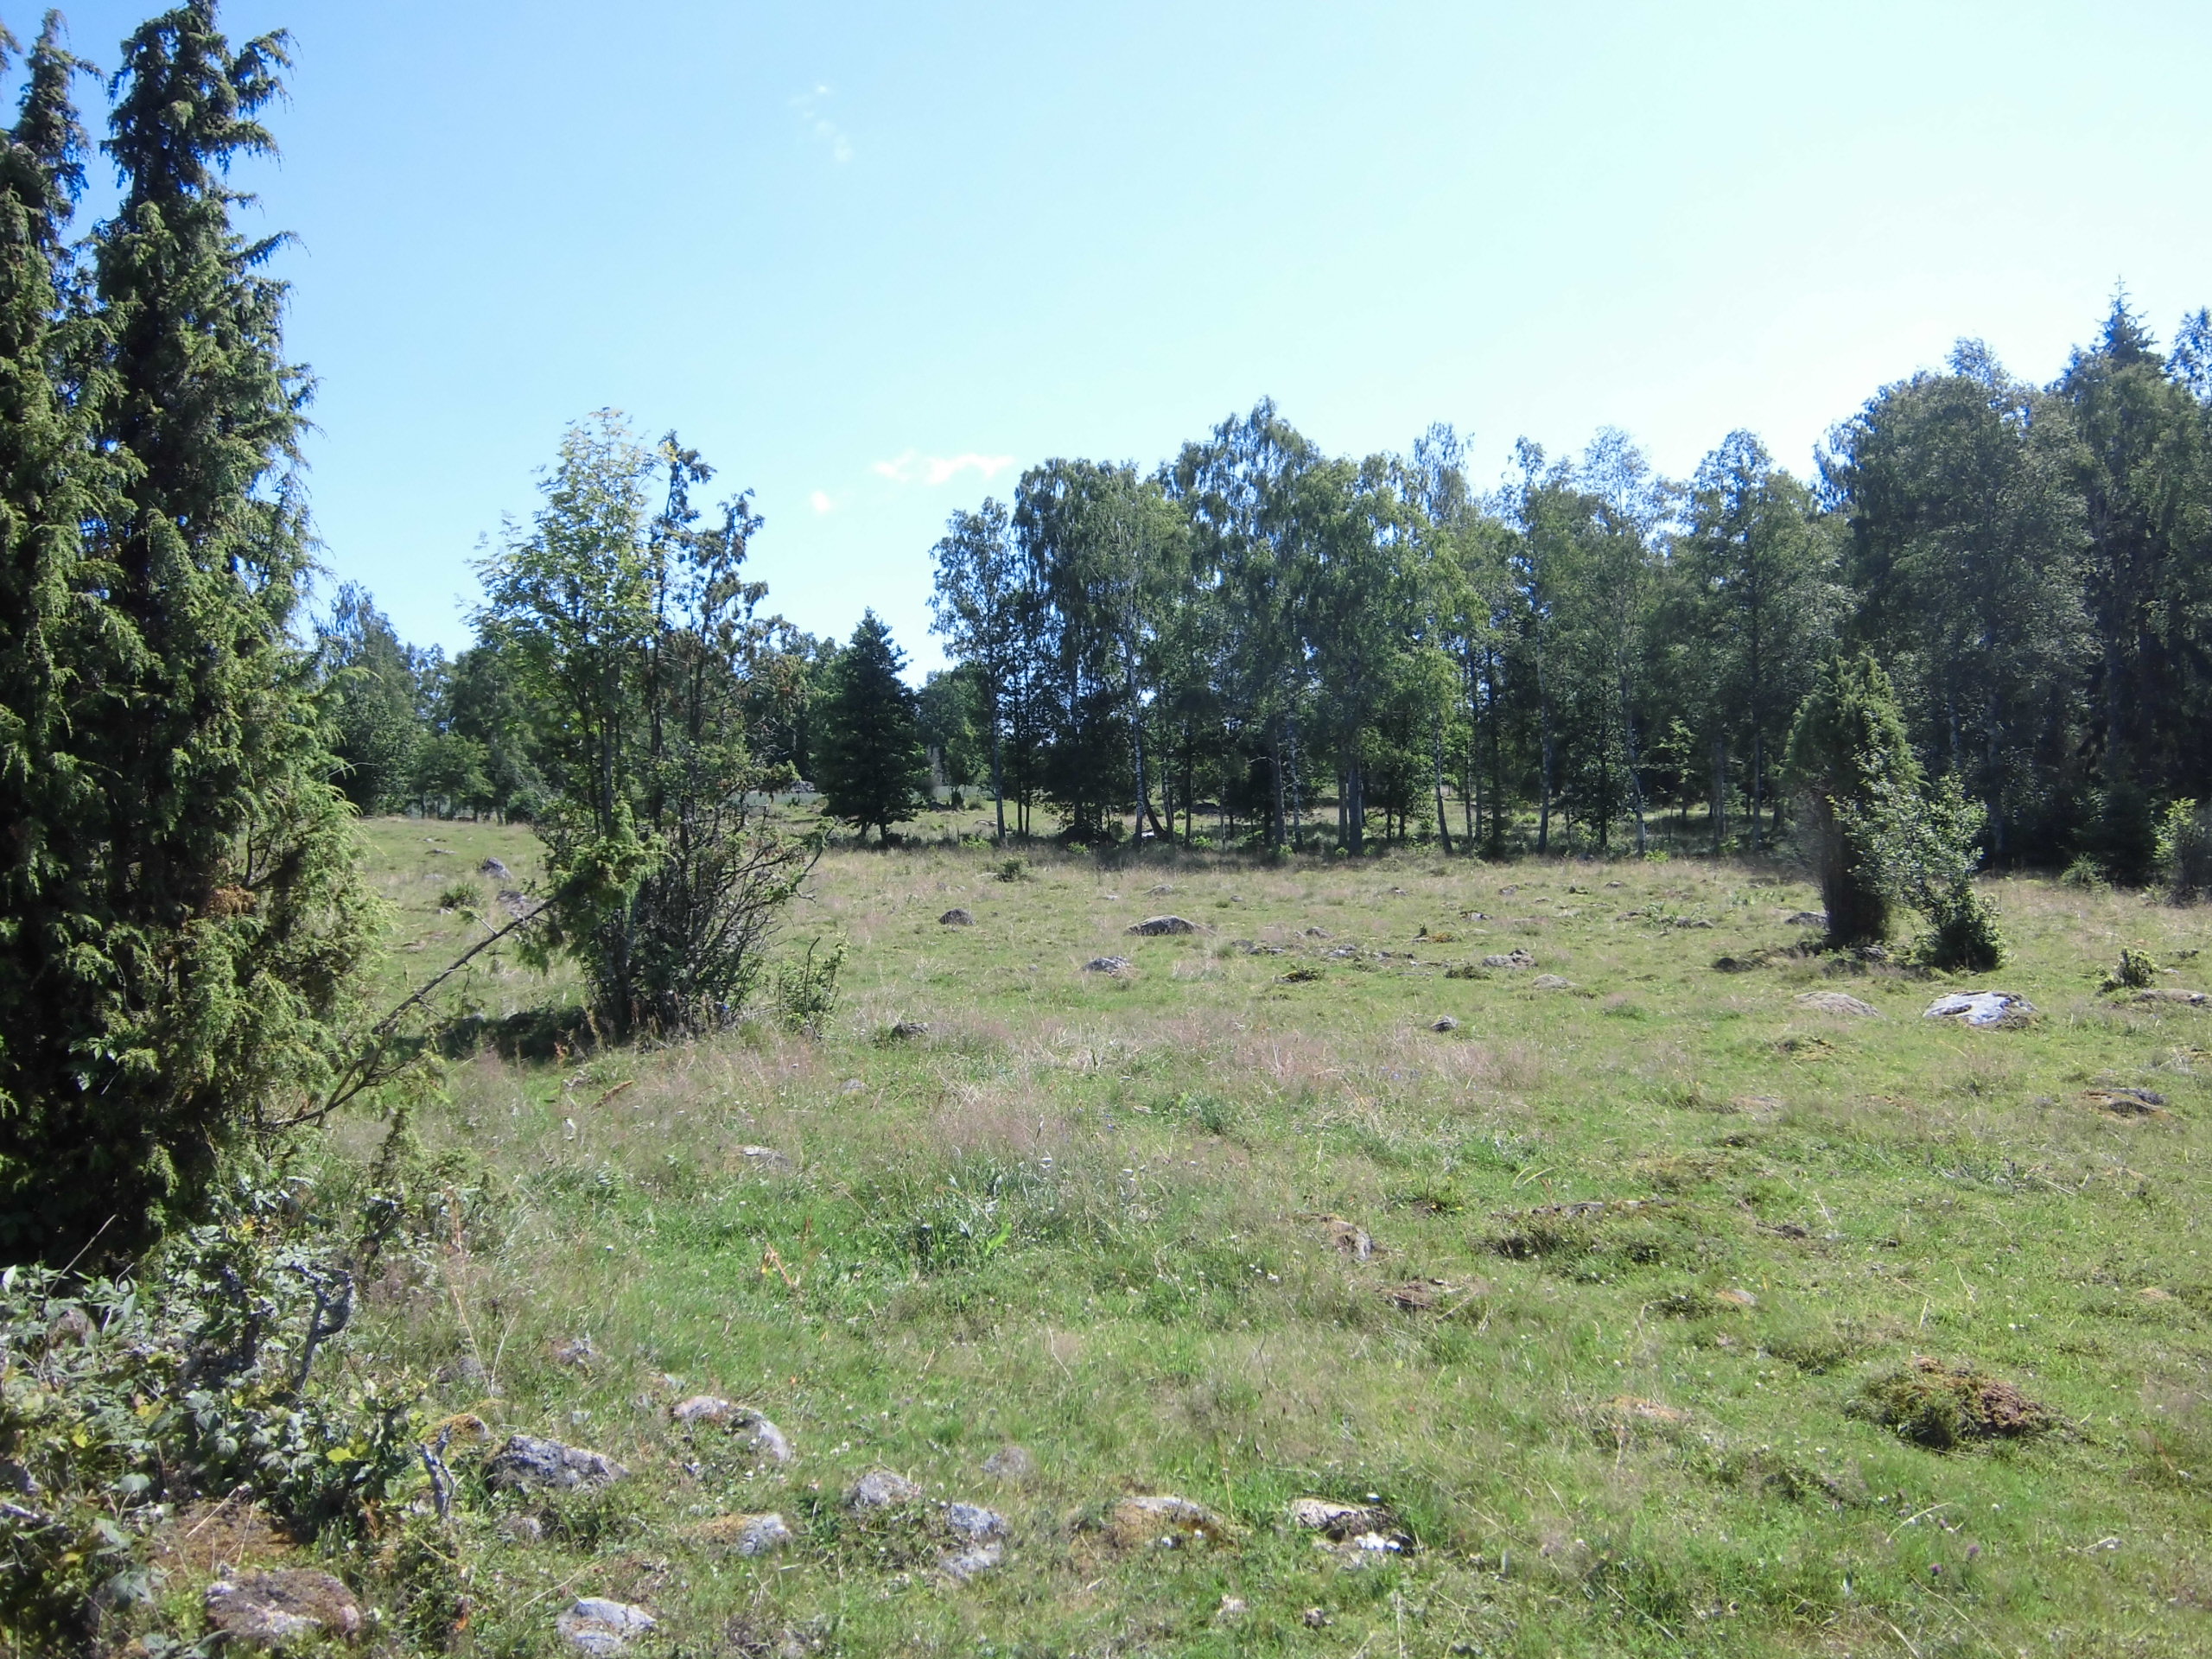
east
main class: Grassland
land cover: Grassland with sparse tree/shrub cover
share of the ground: > 75 %
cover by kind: herbaceous plants 80 %, unconsolidated bare surface 10 %, broadleaved forest trees 5 %, shrubs 5 %
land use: Agriculture (excluding fallow land and kitchen gardens)
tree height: < 5 m
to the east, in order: Grassland with sparse tree/shrub cover; Broadleaved woodland; Grassland with sparse tree/shrub cover; Fences; Oats; Fences; Tracks; Grassland with sparse tree/shrub cover; Fences; Broadleaved woodland
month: July
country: SE
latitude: 57.3387
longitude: 15.3300
